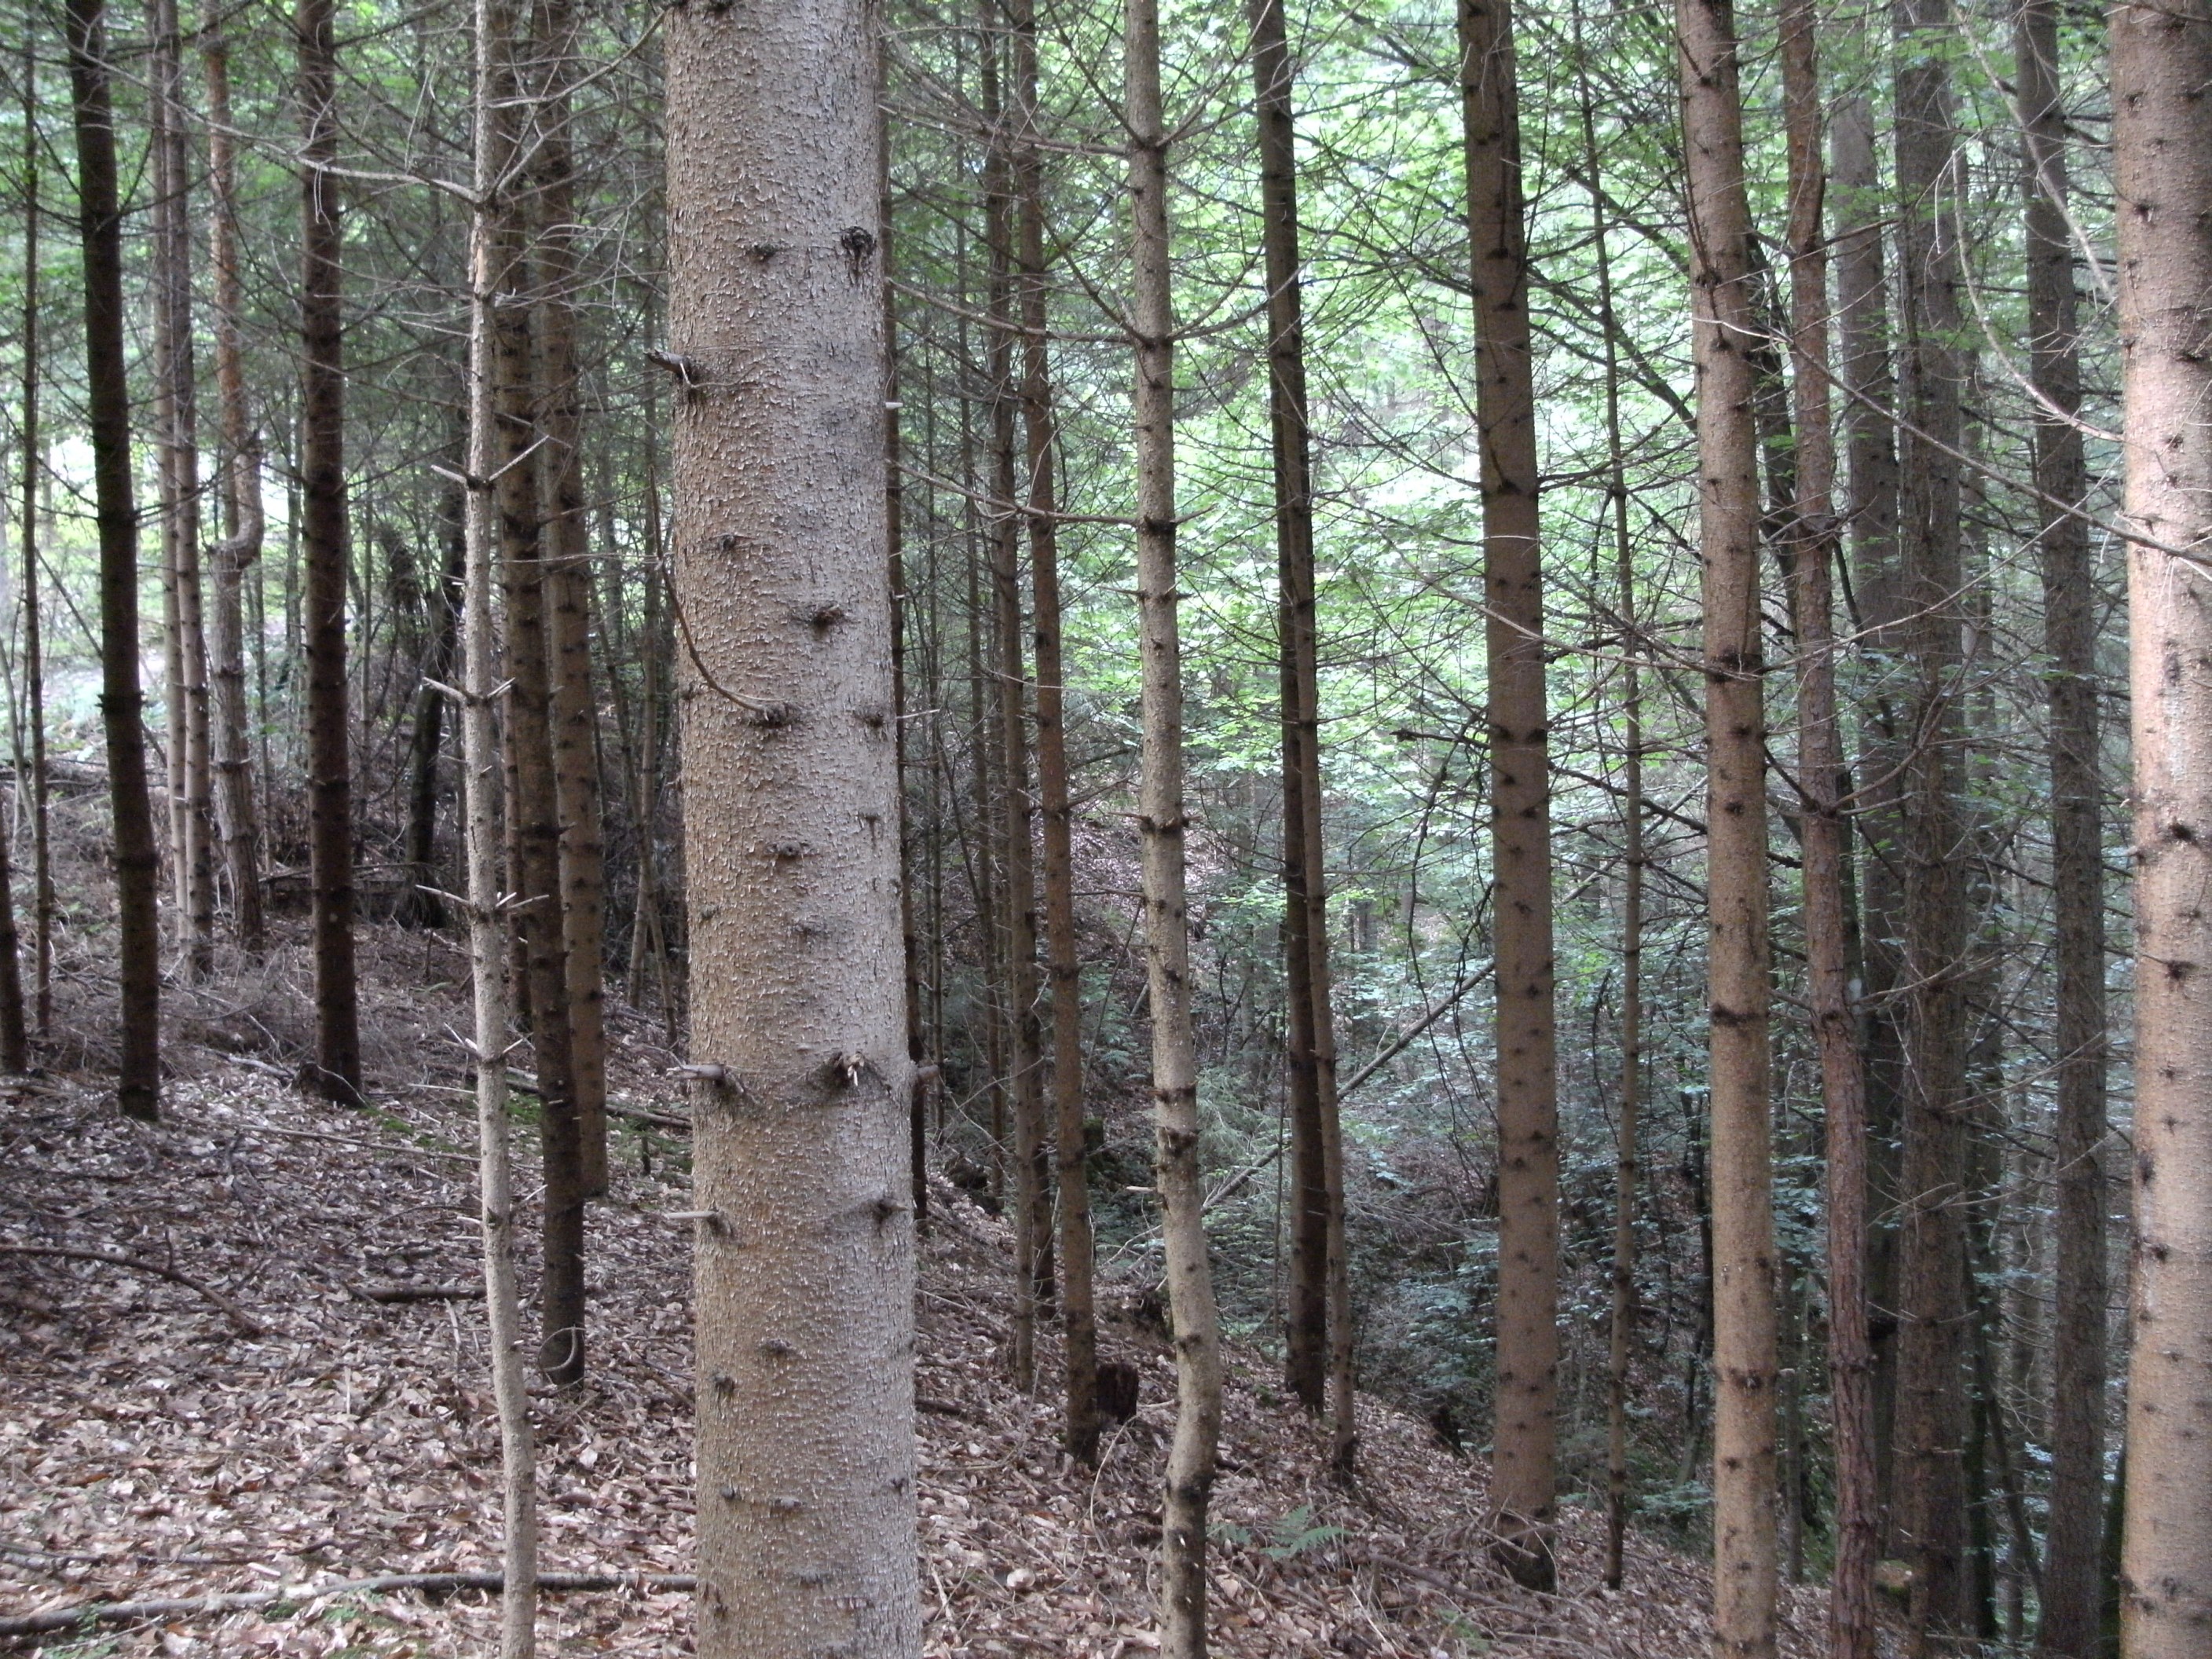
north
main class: Woodland
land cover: Spruce dominated coniferous woodland
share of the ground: > 75 %
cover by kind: coniferous forest trees 80 %, broadleaved forest trees 10 %, unconsolidated bare surface 10 %
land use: Forestry
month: July
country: AT
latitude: 46.5959
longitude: 14.5793
